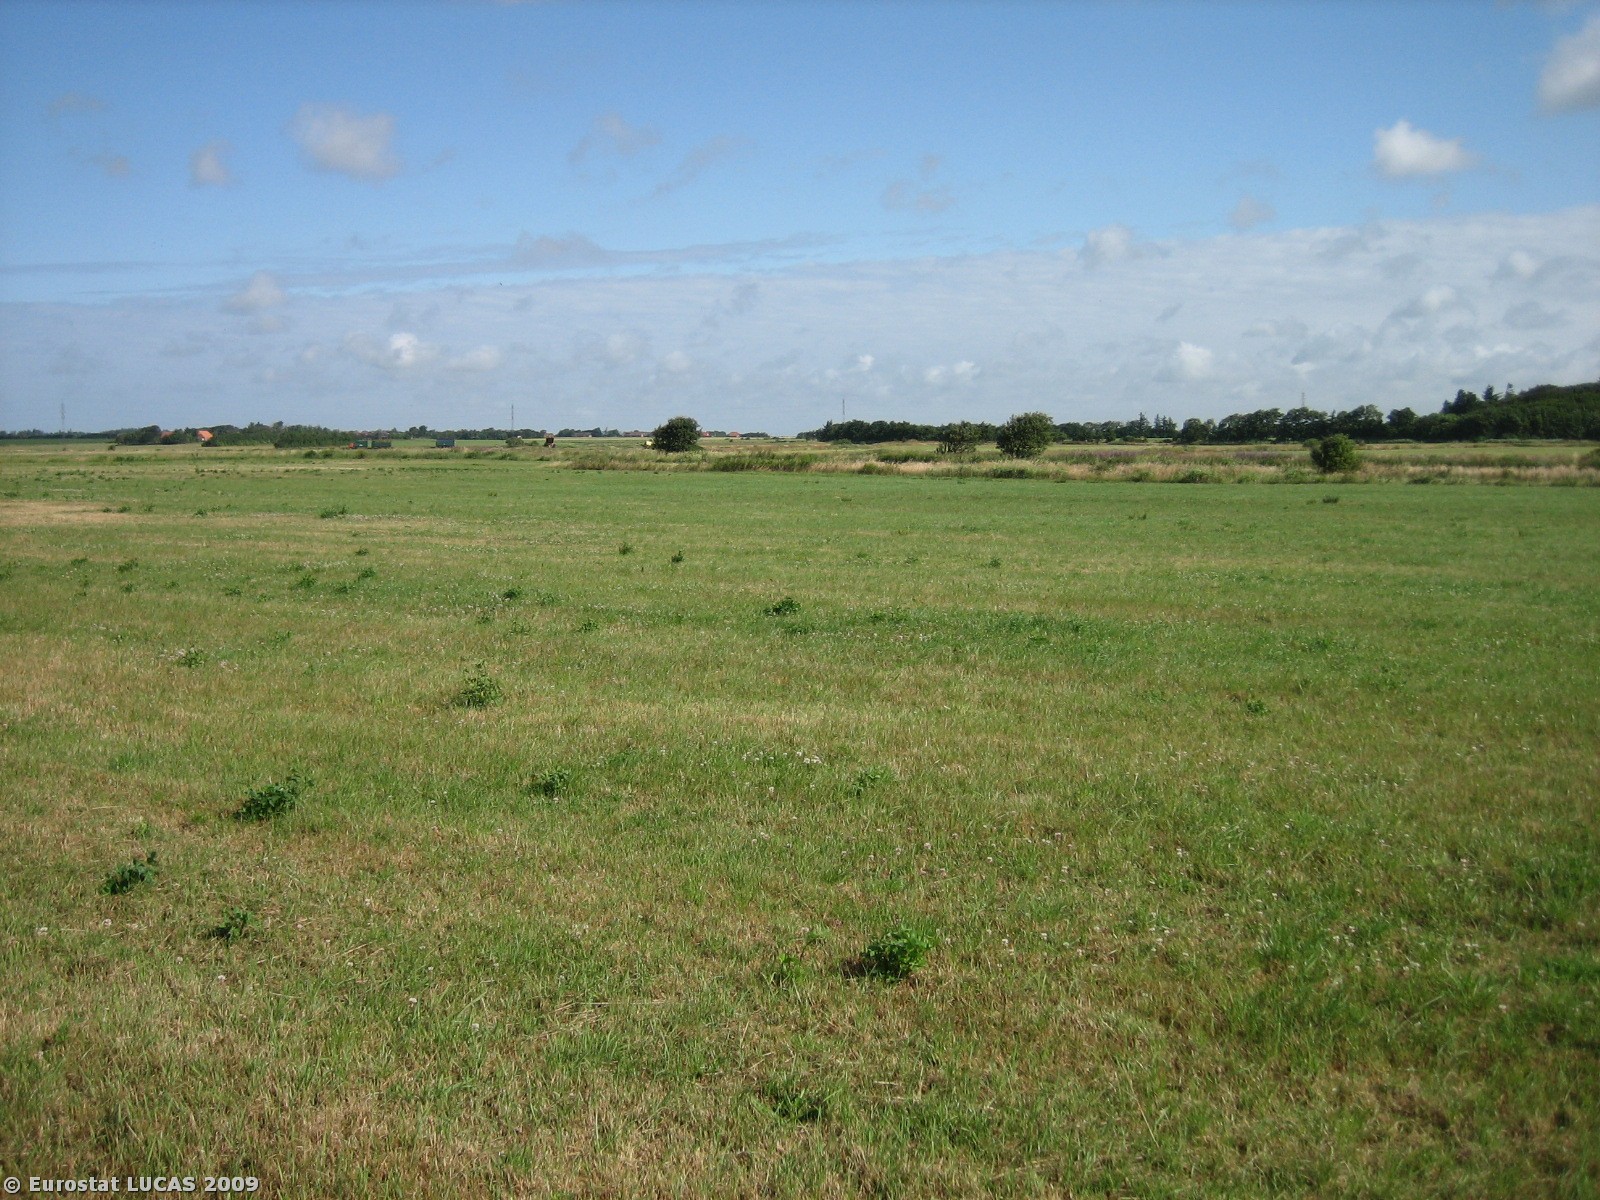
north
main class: Grassland
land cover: Grassland without tree/shrub cover
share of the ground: > 75 %
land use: Agriculture (excluding fallow land and kitchen gardens)
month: July
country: DK
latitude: 55.7270
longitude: 8.2979
